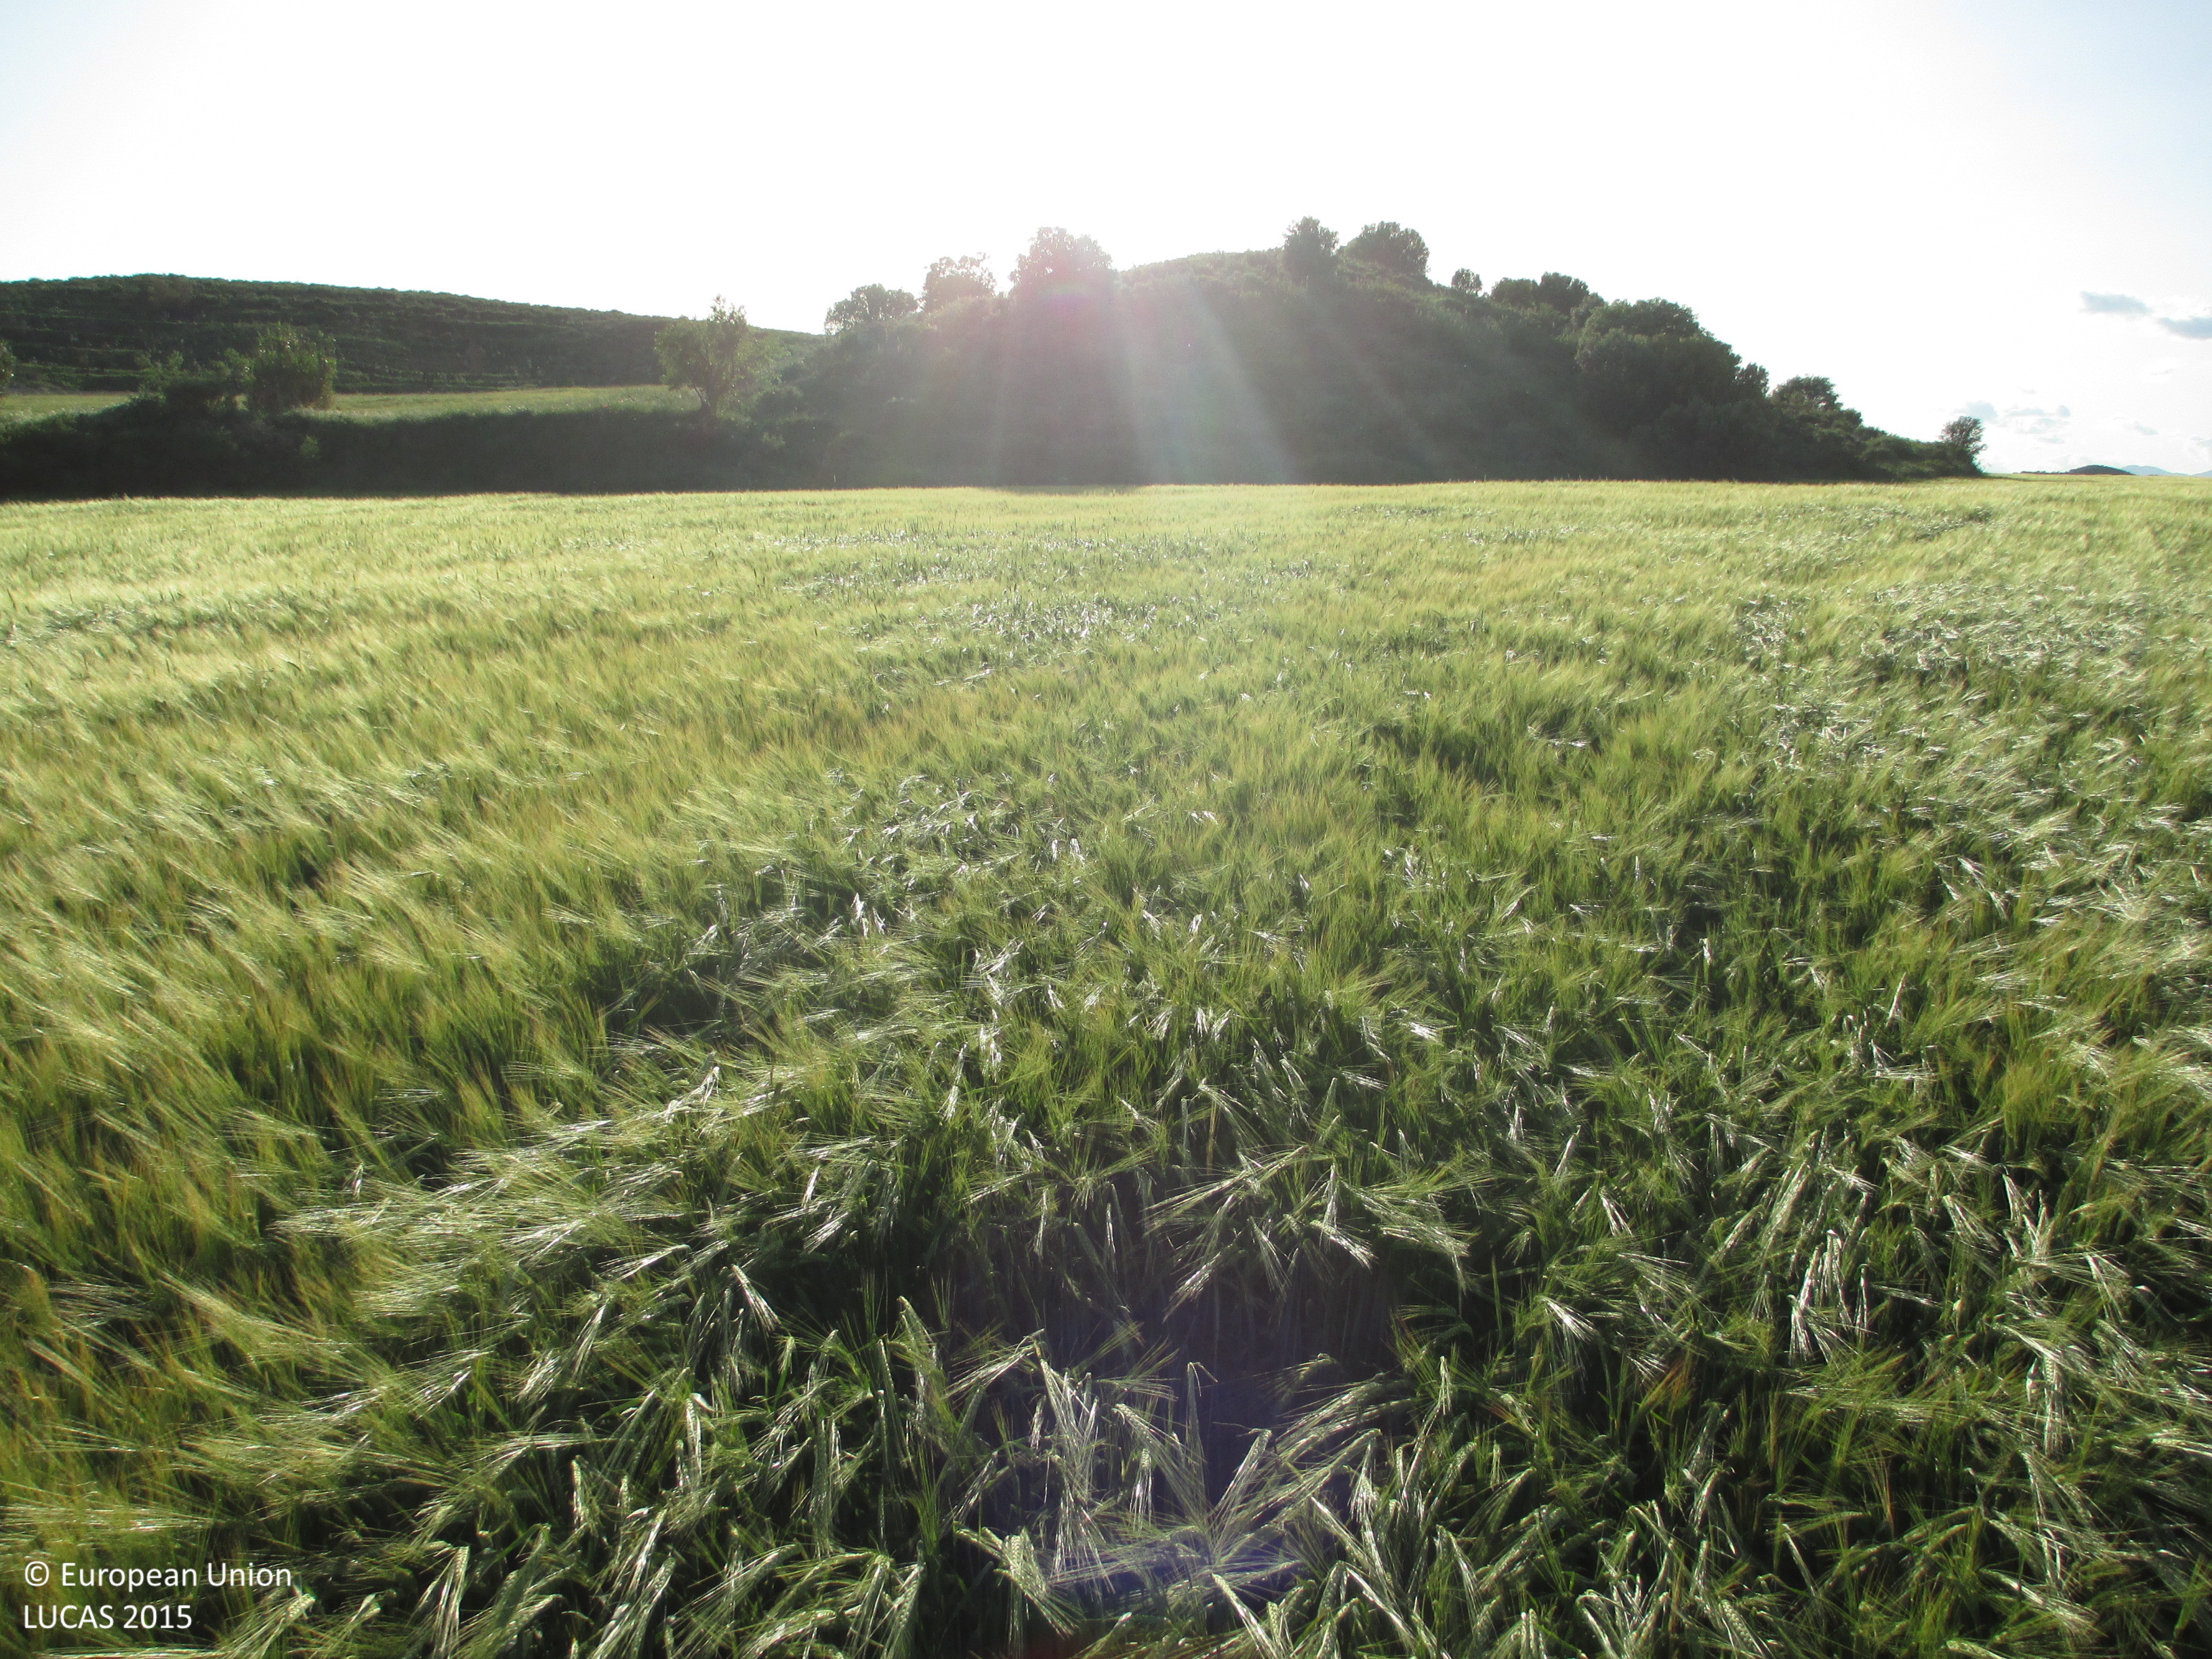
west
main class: Cropland
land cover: Barley
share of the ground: > 75 %
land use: Agriculture (excluding fallow land and kitchen gardens)
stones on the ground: < 10 %
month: May
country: ES
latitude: 42.0501
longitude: 0.0131
